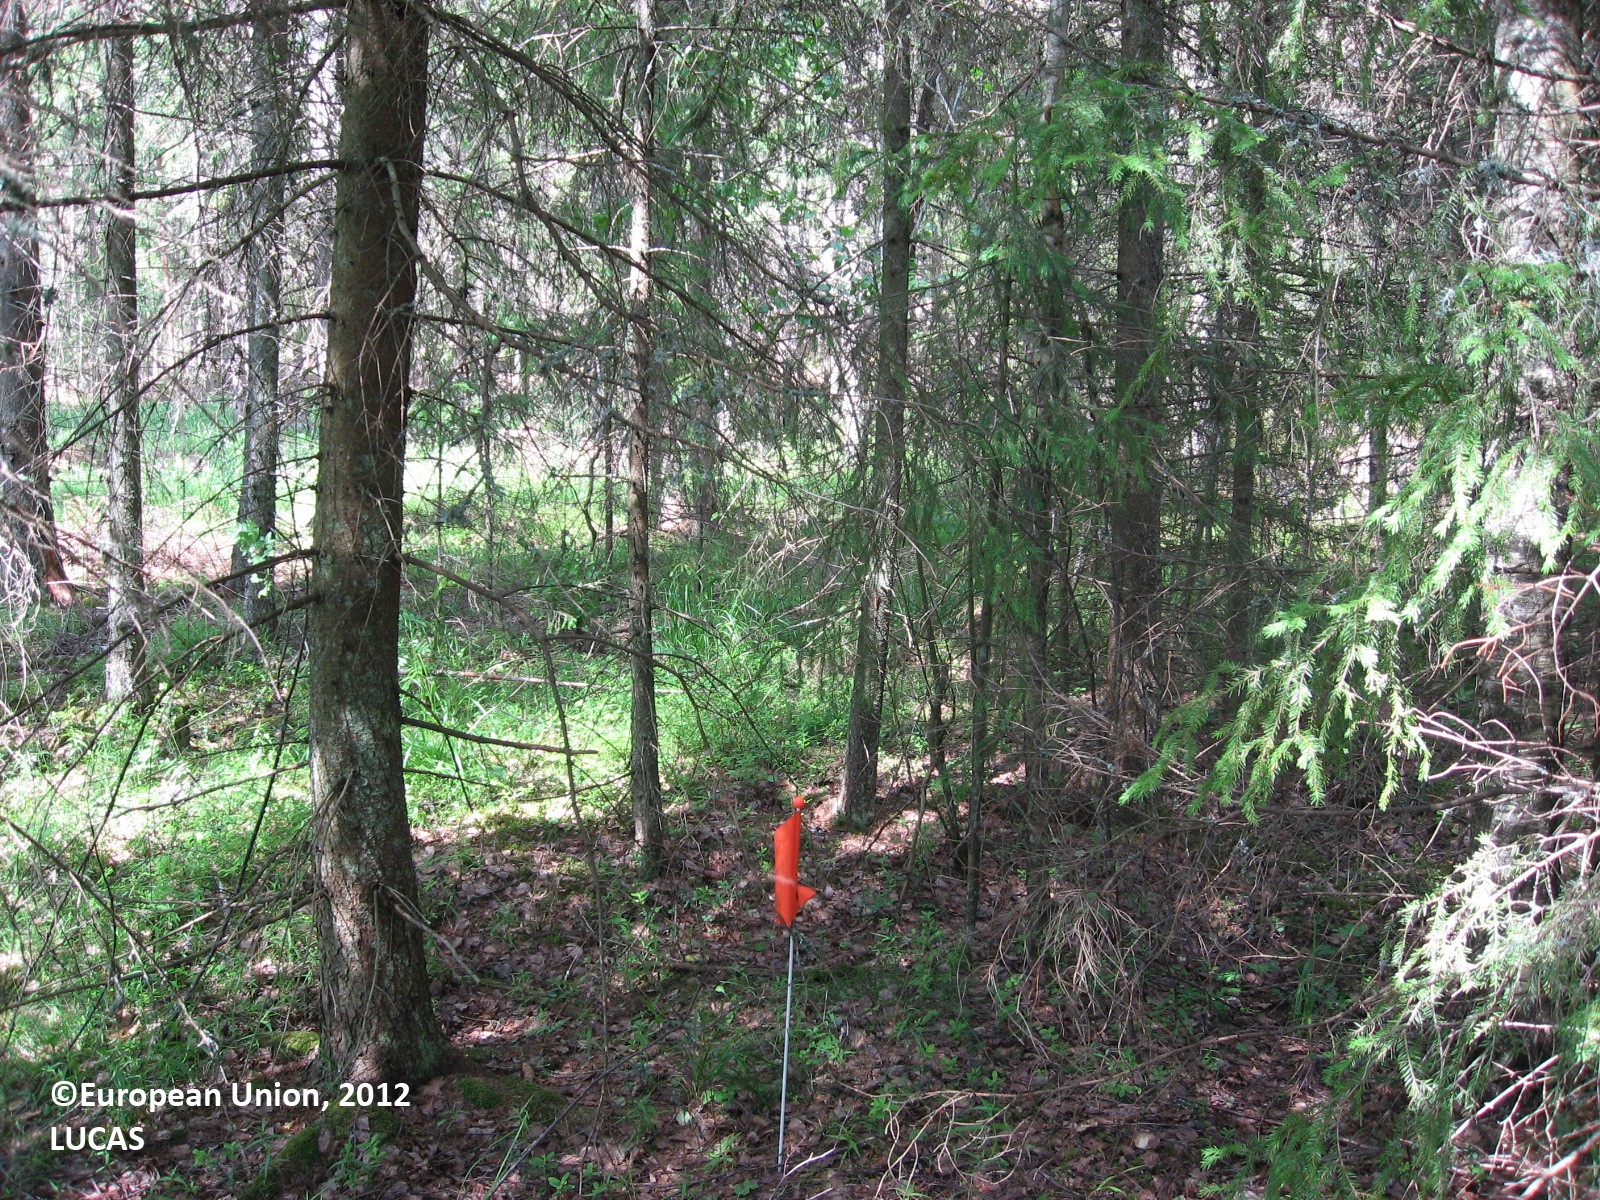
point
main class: Woodland
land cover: Spruce dominated mixed woodland
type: boreal forest
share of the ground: > 75 %
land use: Forestry
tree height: > 5 m
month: June
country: FI
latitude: 60.6452
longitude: 26.5980
